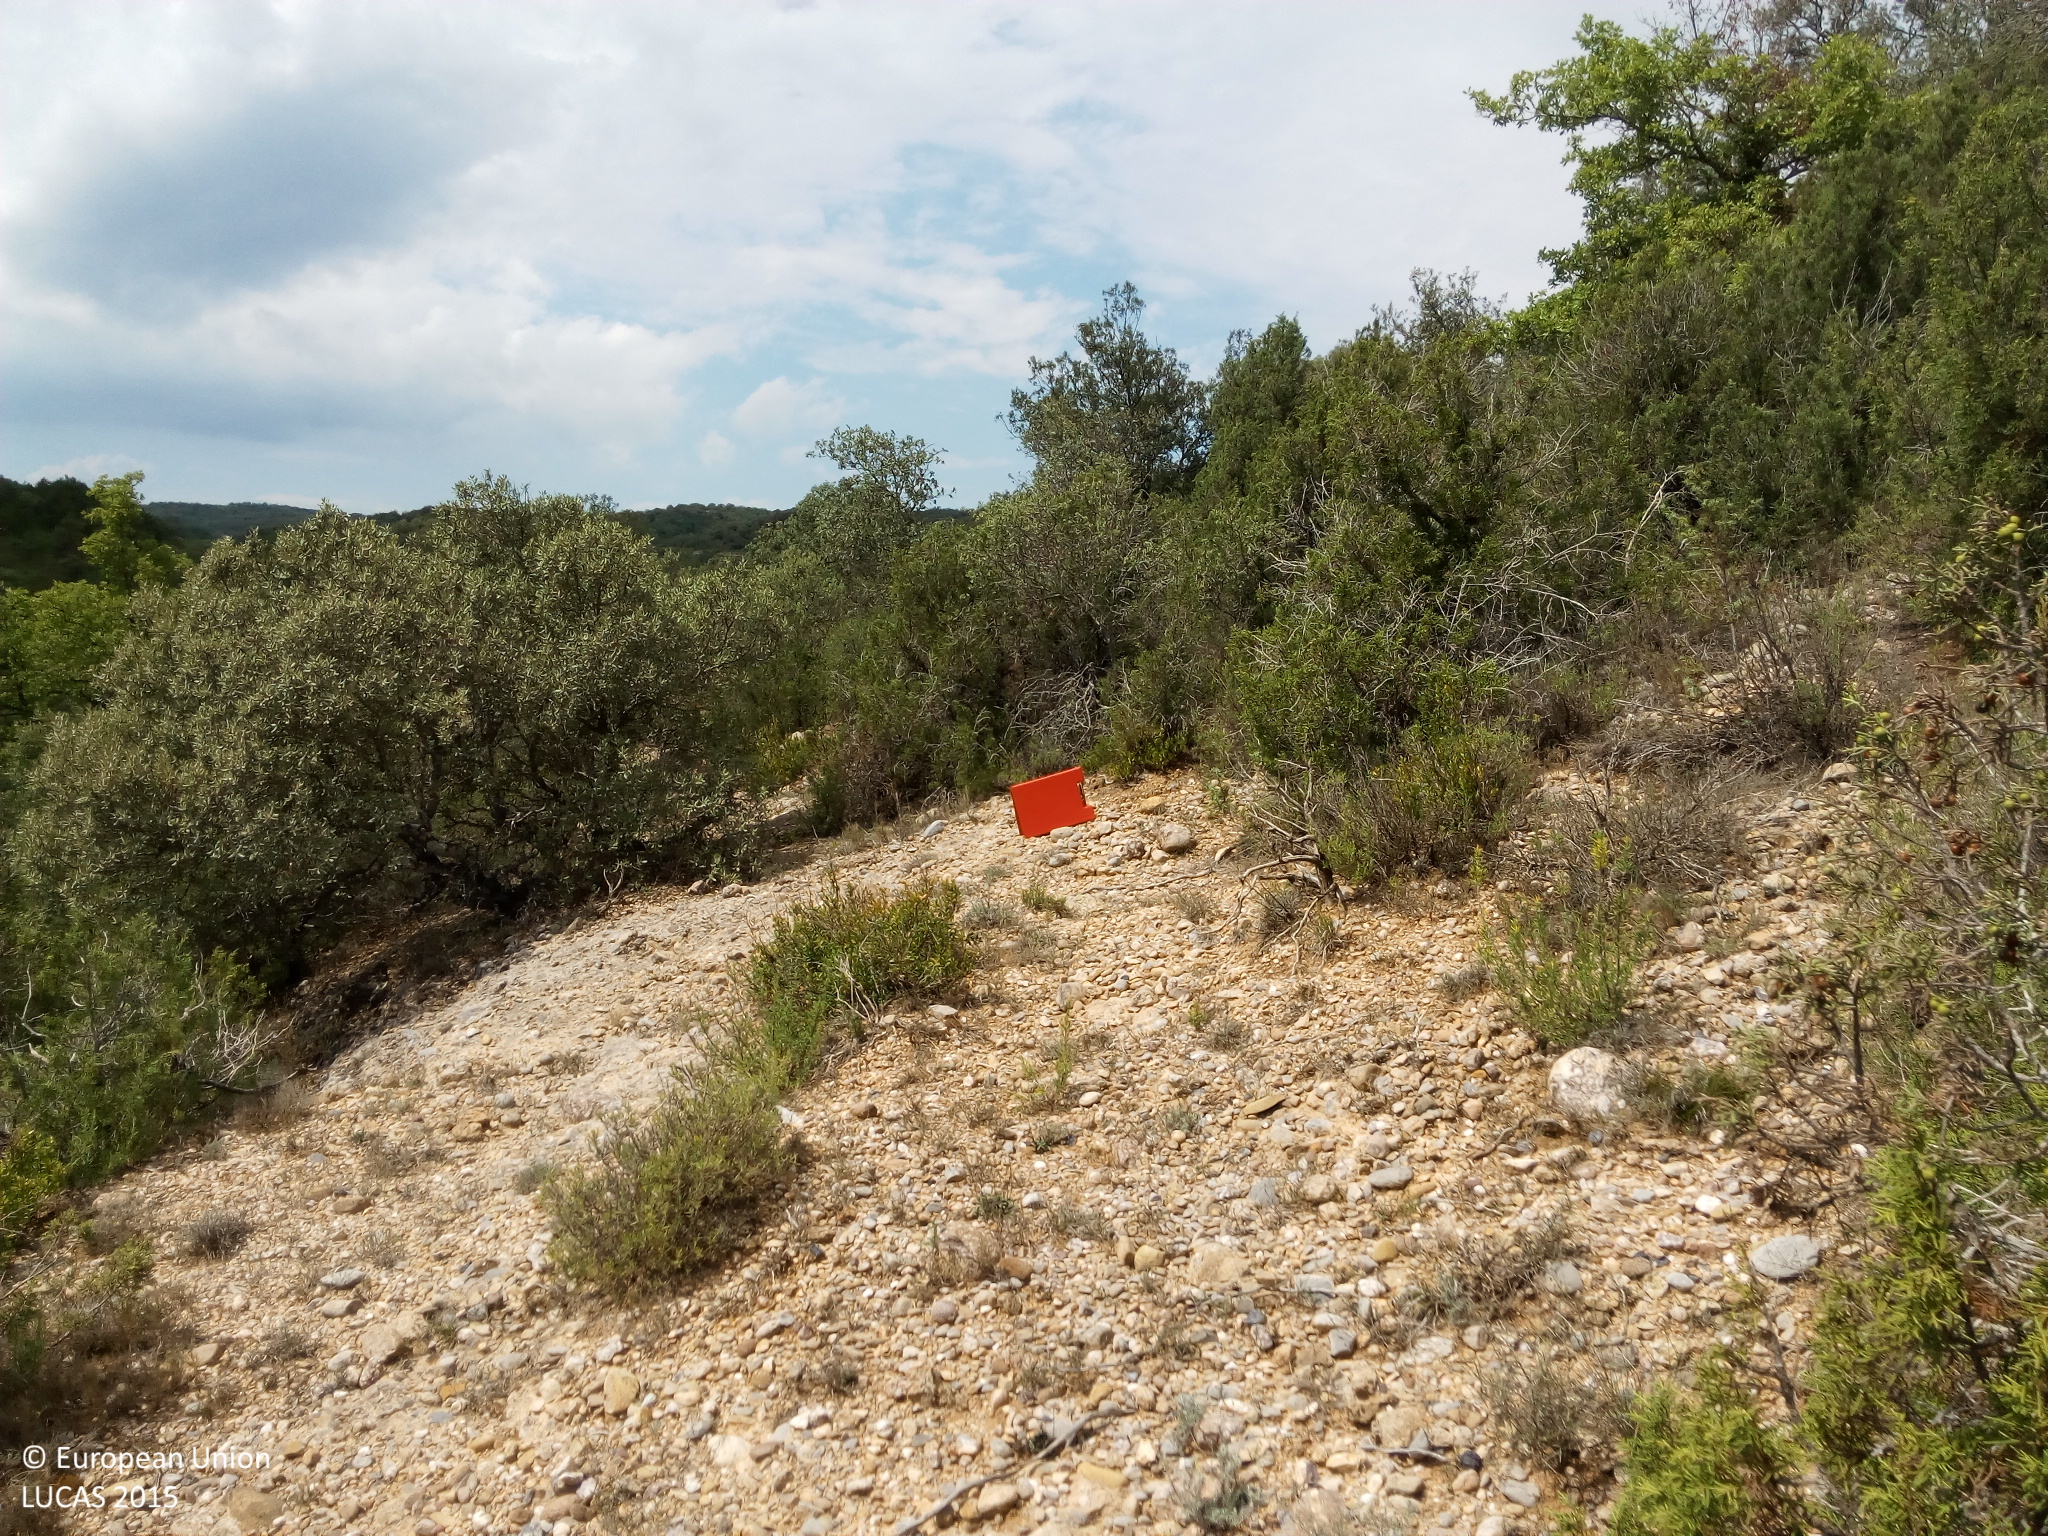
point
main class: Woodland
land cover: Broadleaved woodland
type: broadleaved evergreen forest
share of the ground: > 75 %
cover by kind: shrubs 30 %, herbaceous plants 30 %, broadleaved forest trees 20 %, consolidated bare surface 20 %
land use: Semi-natural and natural areas not in use
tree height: < 5 m
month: August
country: ES
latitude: 42.1192
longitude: 0.5369
